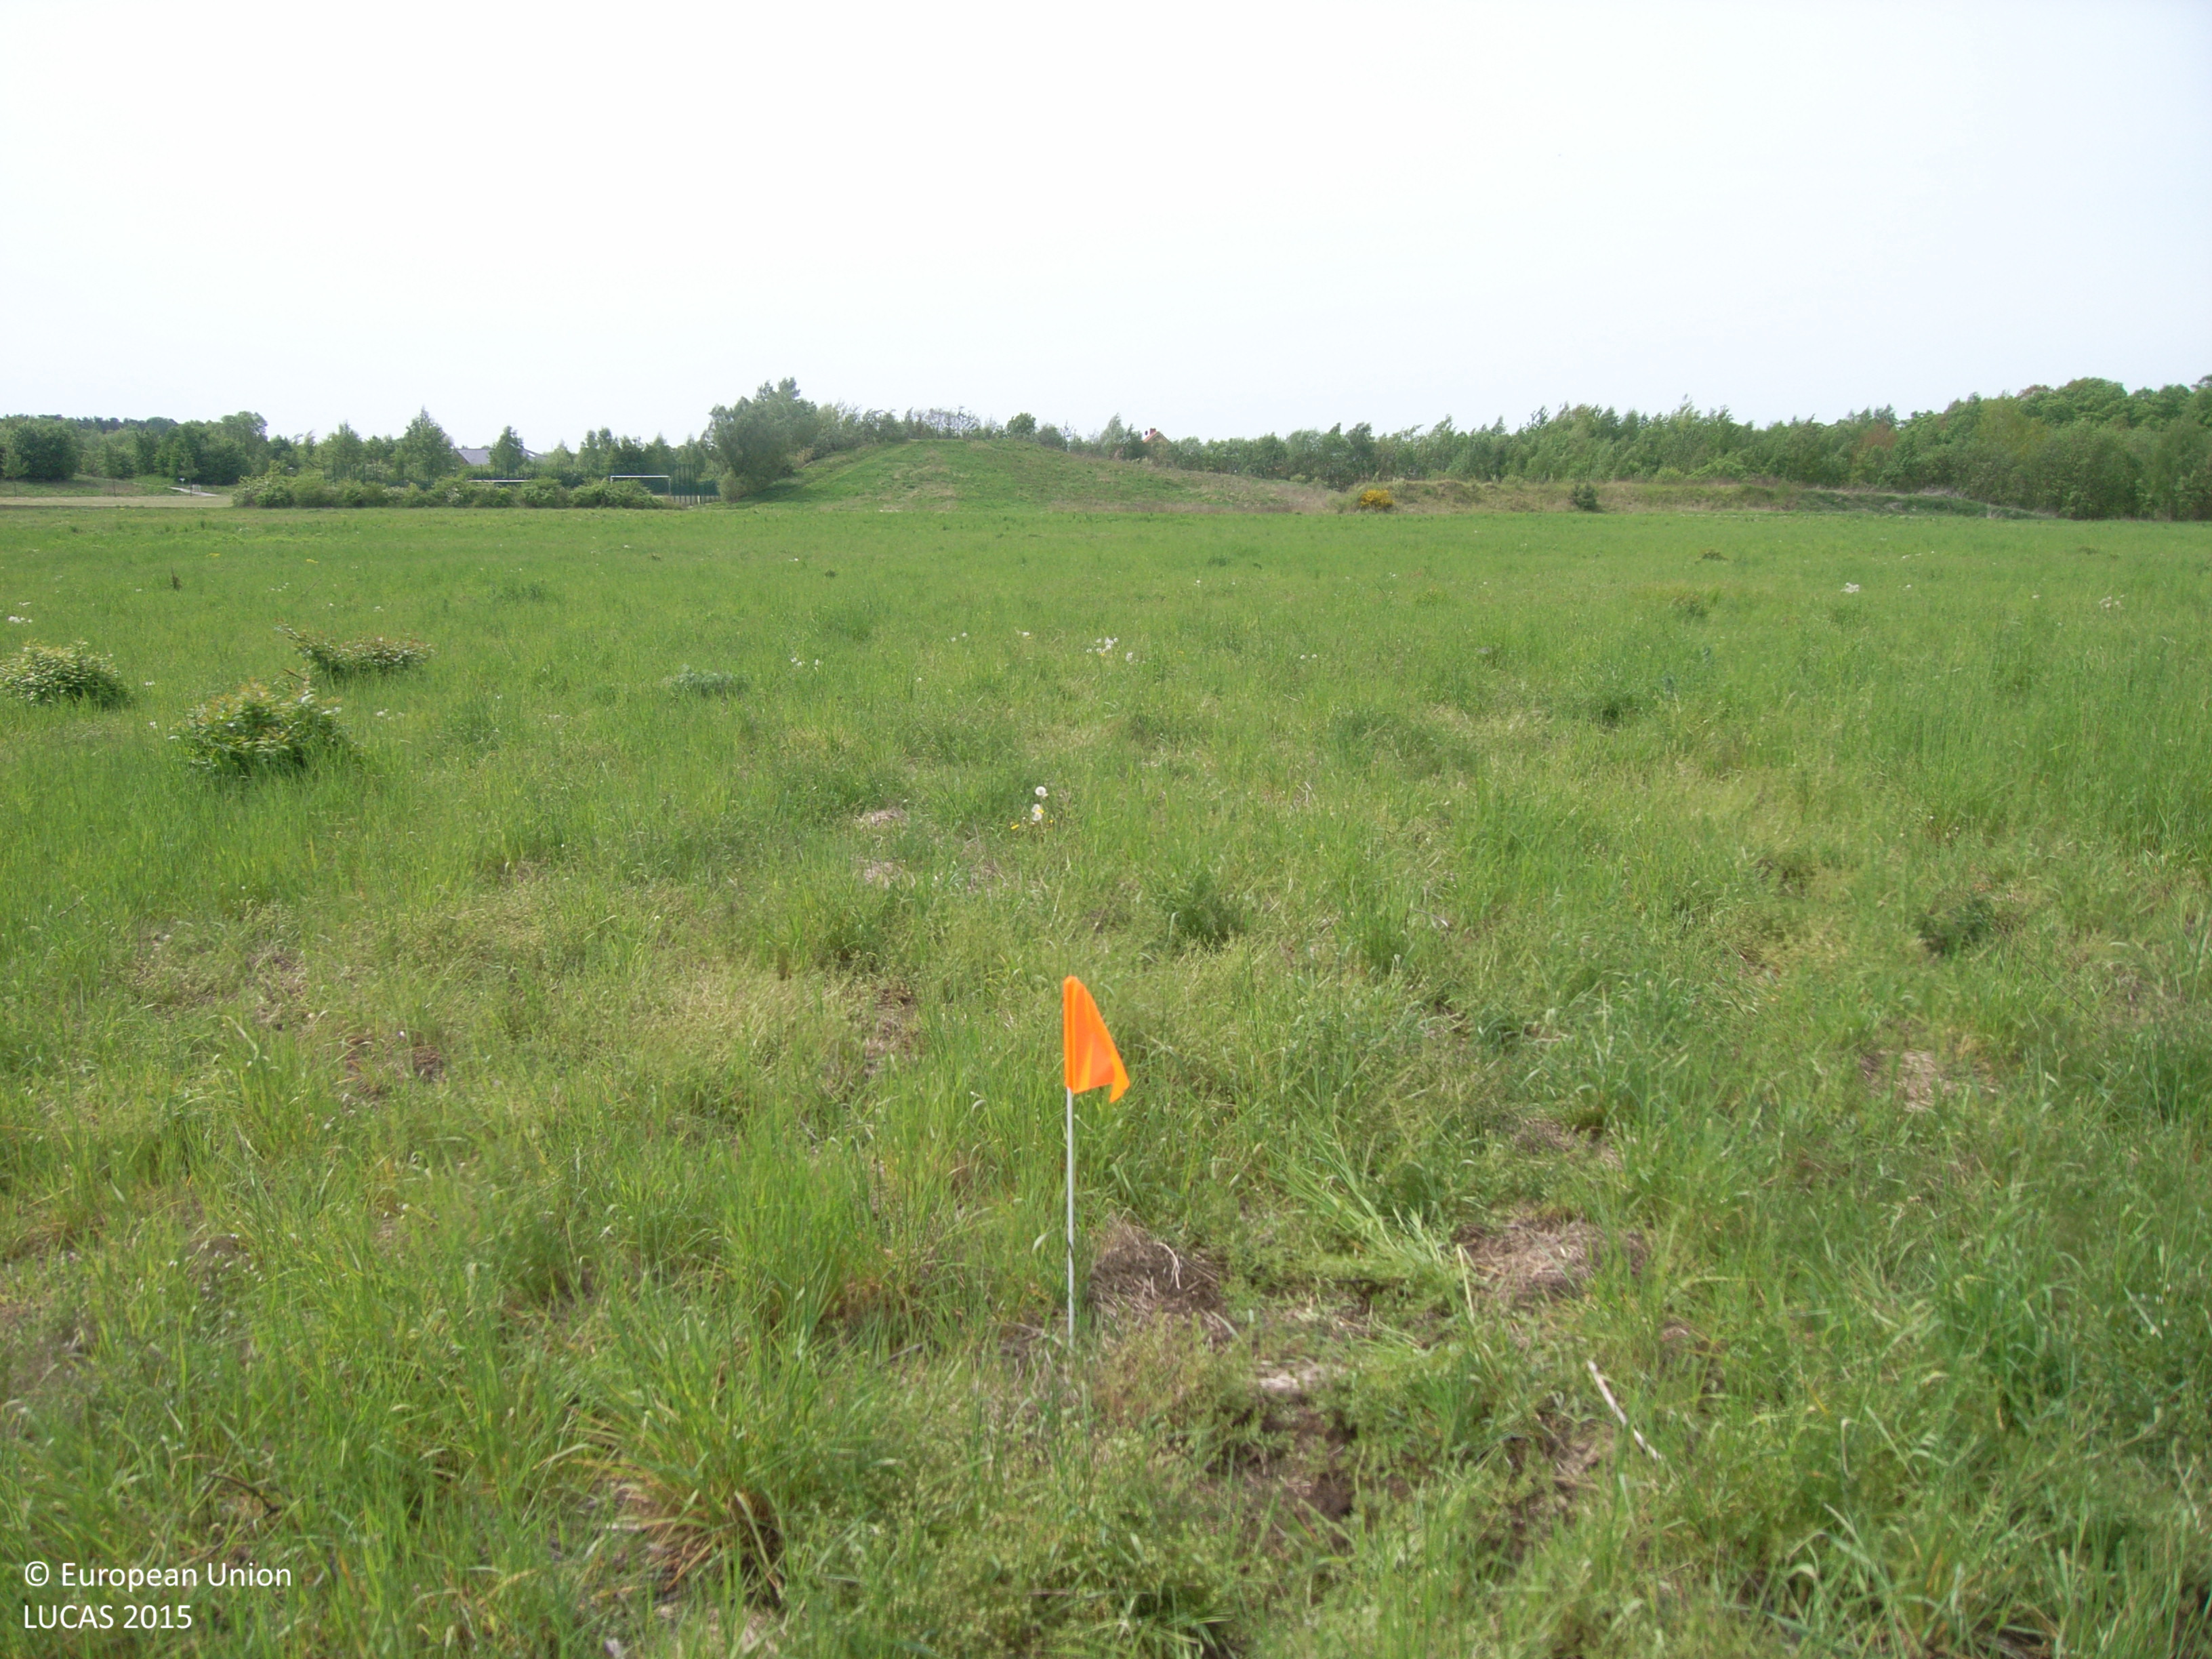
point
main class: Grassland
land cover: Grassland with sparse tree/shrub cover
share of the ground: > 75 %
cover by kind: herbaceous plants 95 %, broadleaved forest trees 5 %
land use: Abandoned areas
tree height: < 5 m
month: May
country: DE
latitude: 52.3051
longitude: 13.5935
